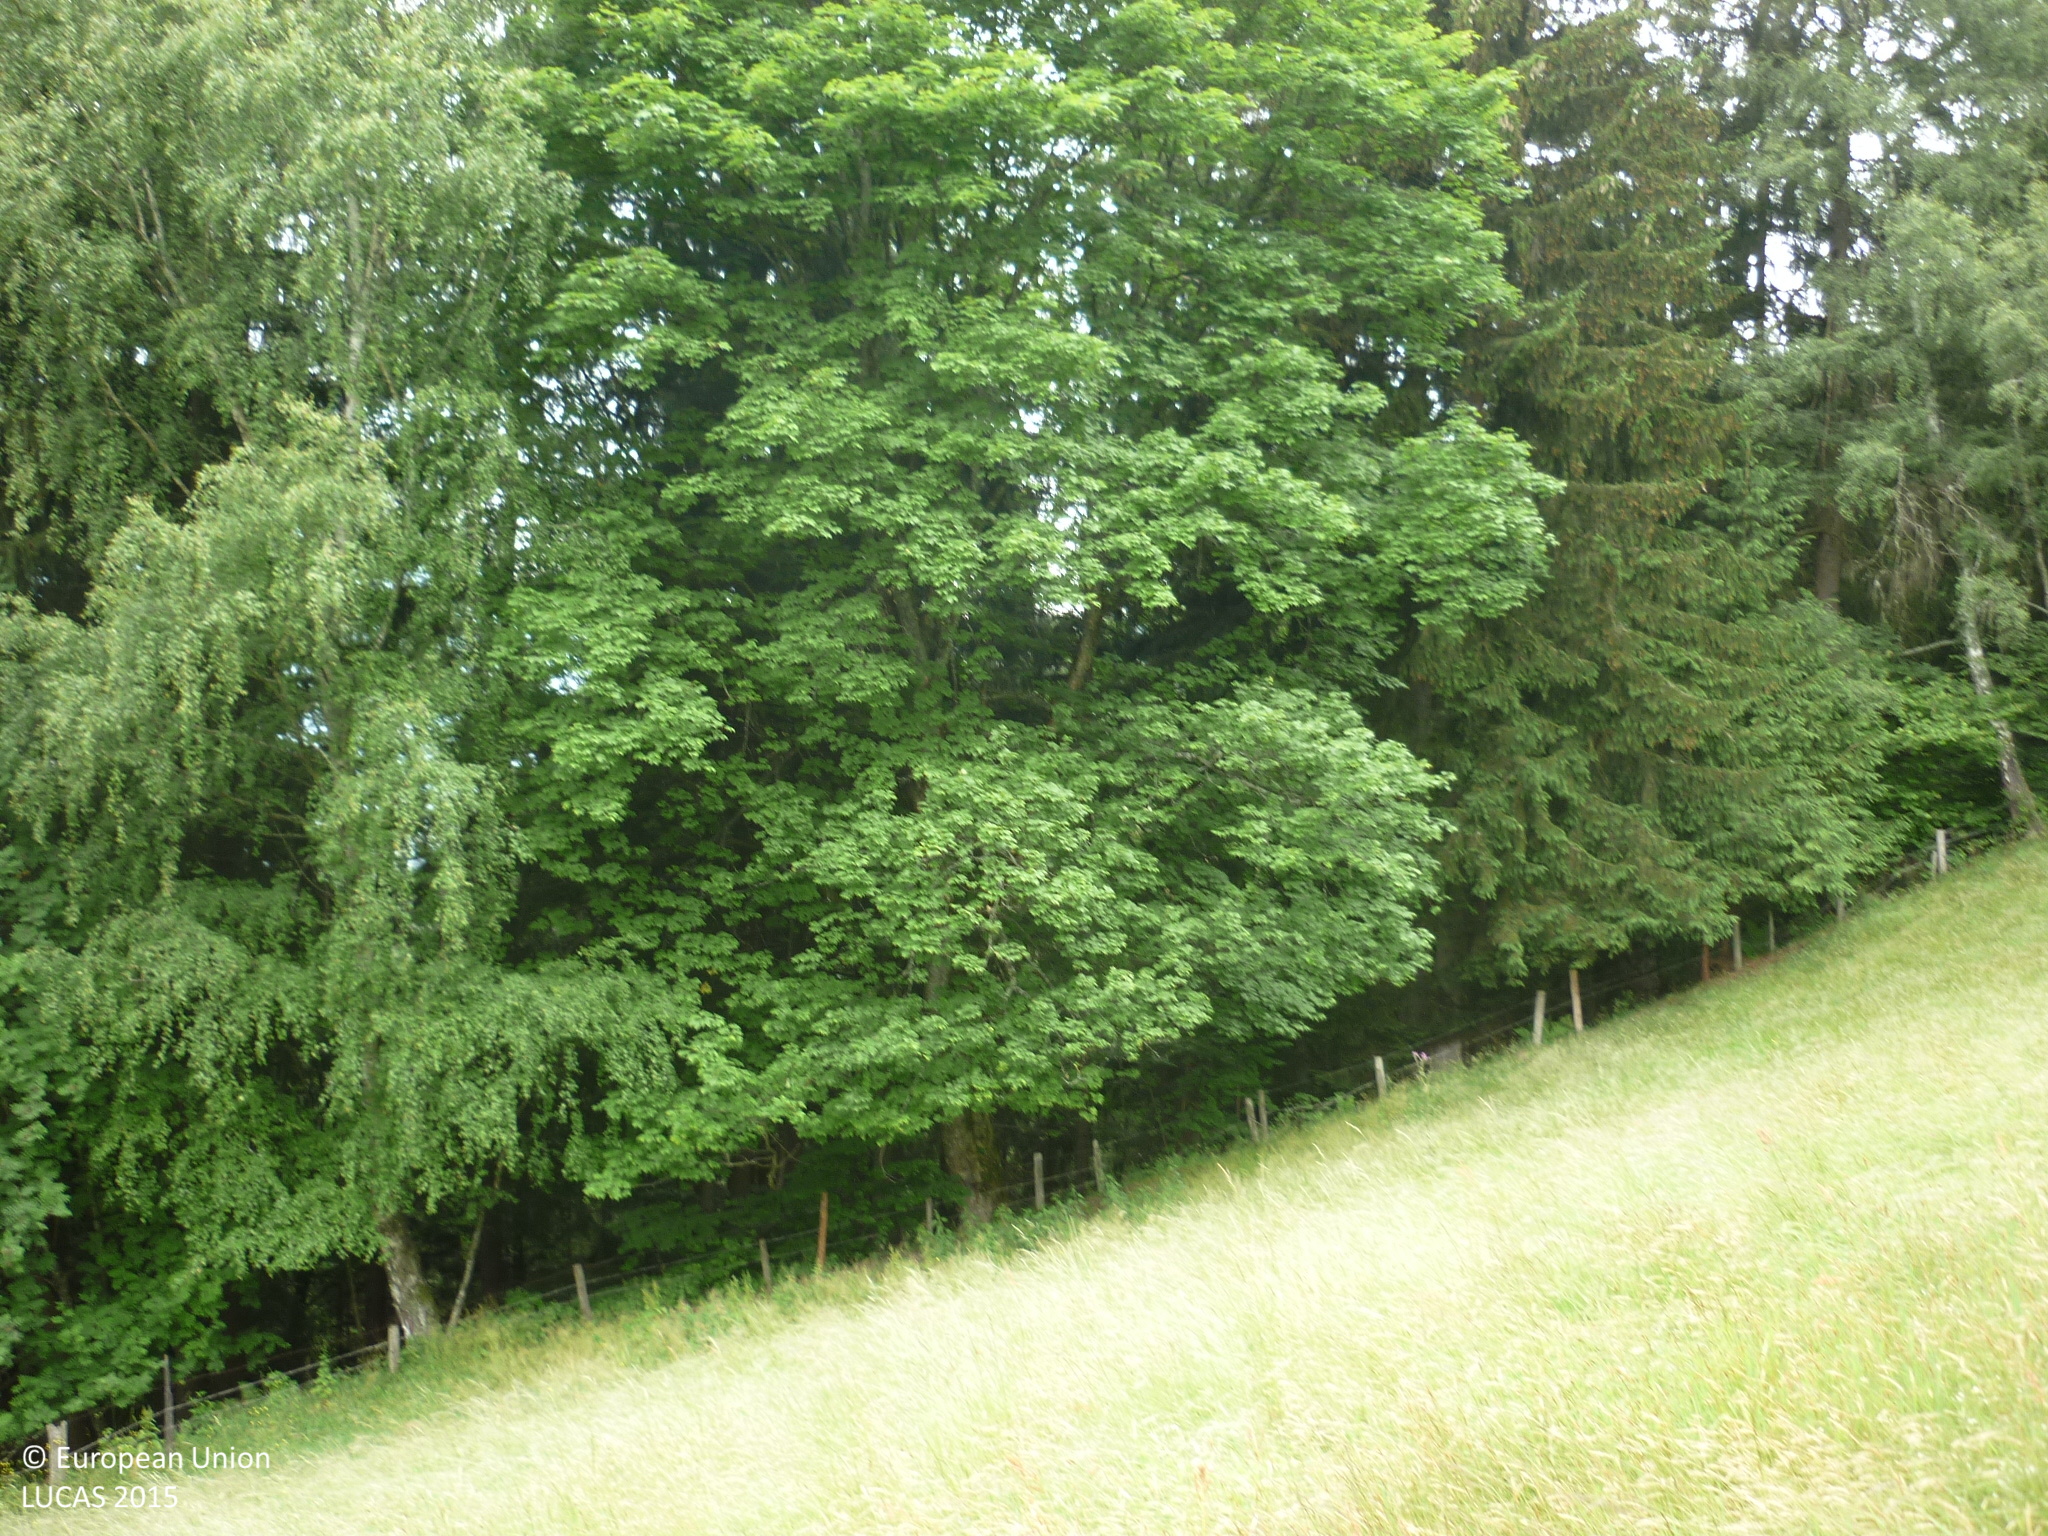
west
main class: Grassland
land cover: Grassland without tree/shrub cover
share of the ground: > 75 %
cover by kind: herbaceous plants 100 %
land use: Agriculture (excluding fallow land and kitchen gardens)
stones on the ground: < 10 %
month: June
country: AT
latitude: 47.4998
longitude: 14.5260
